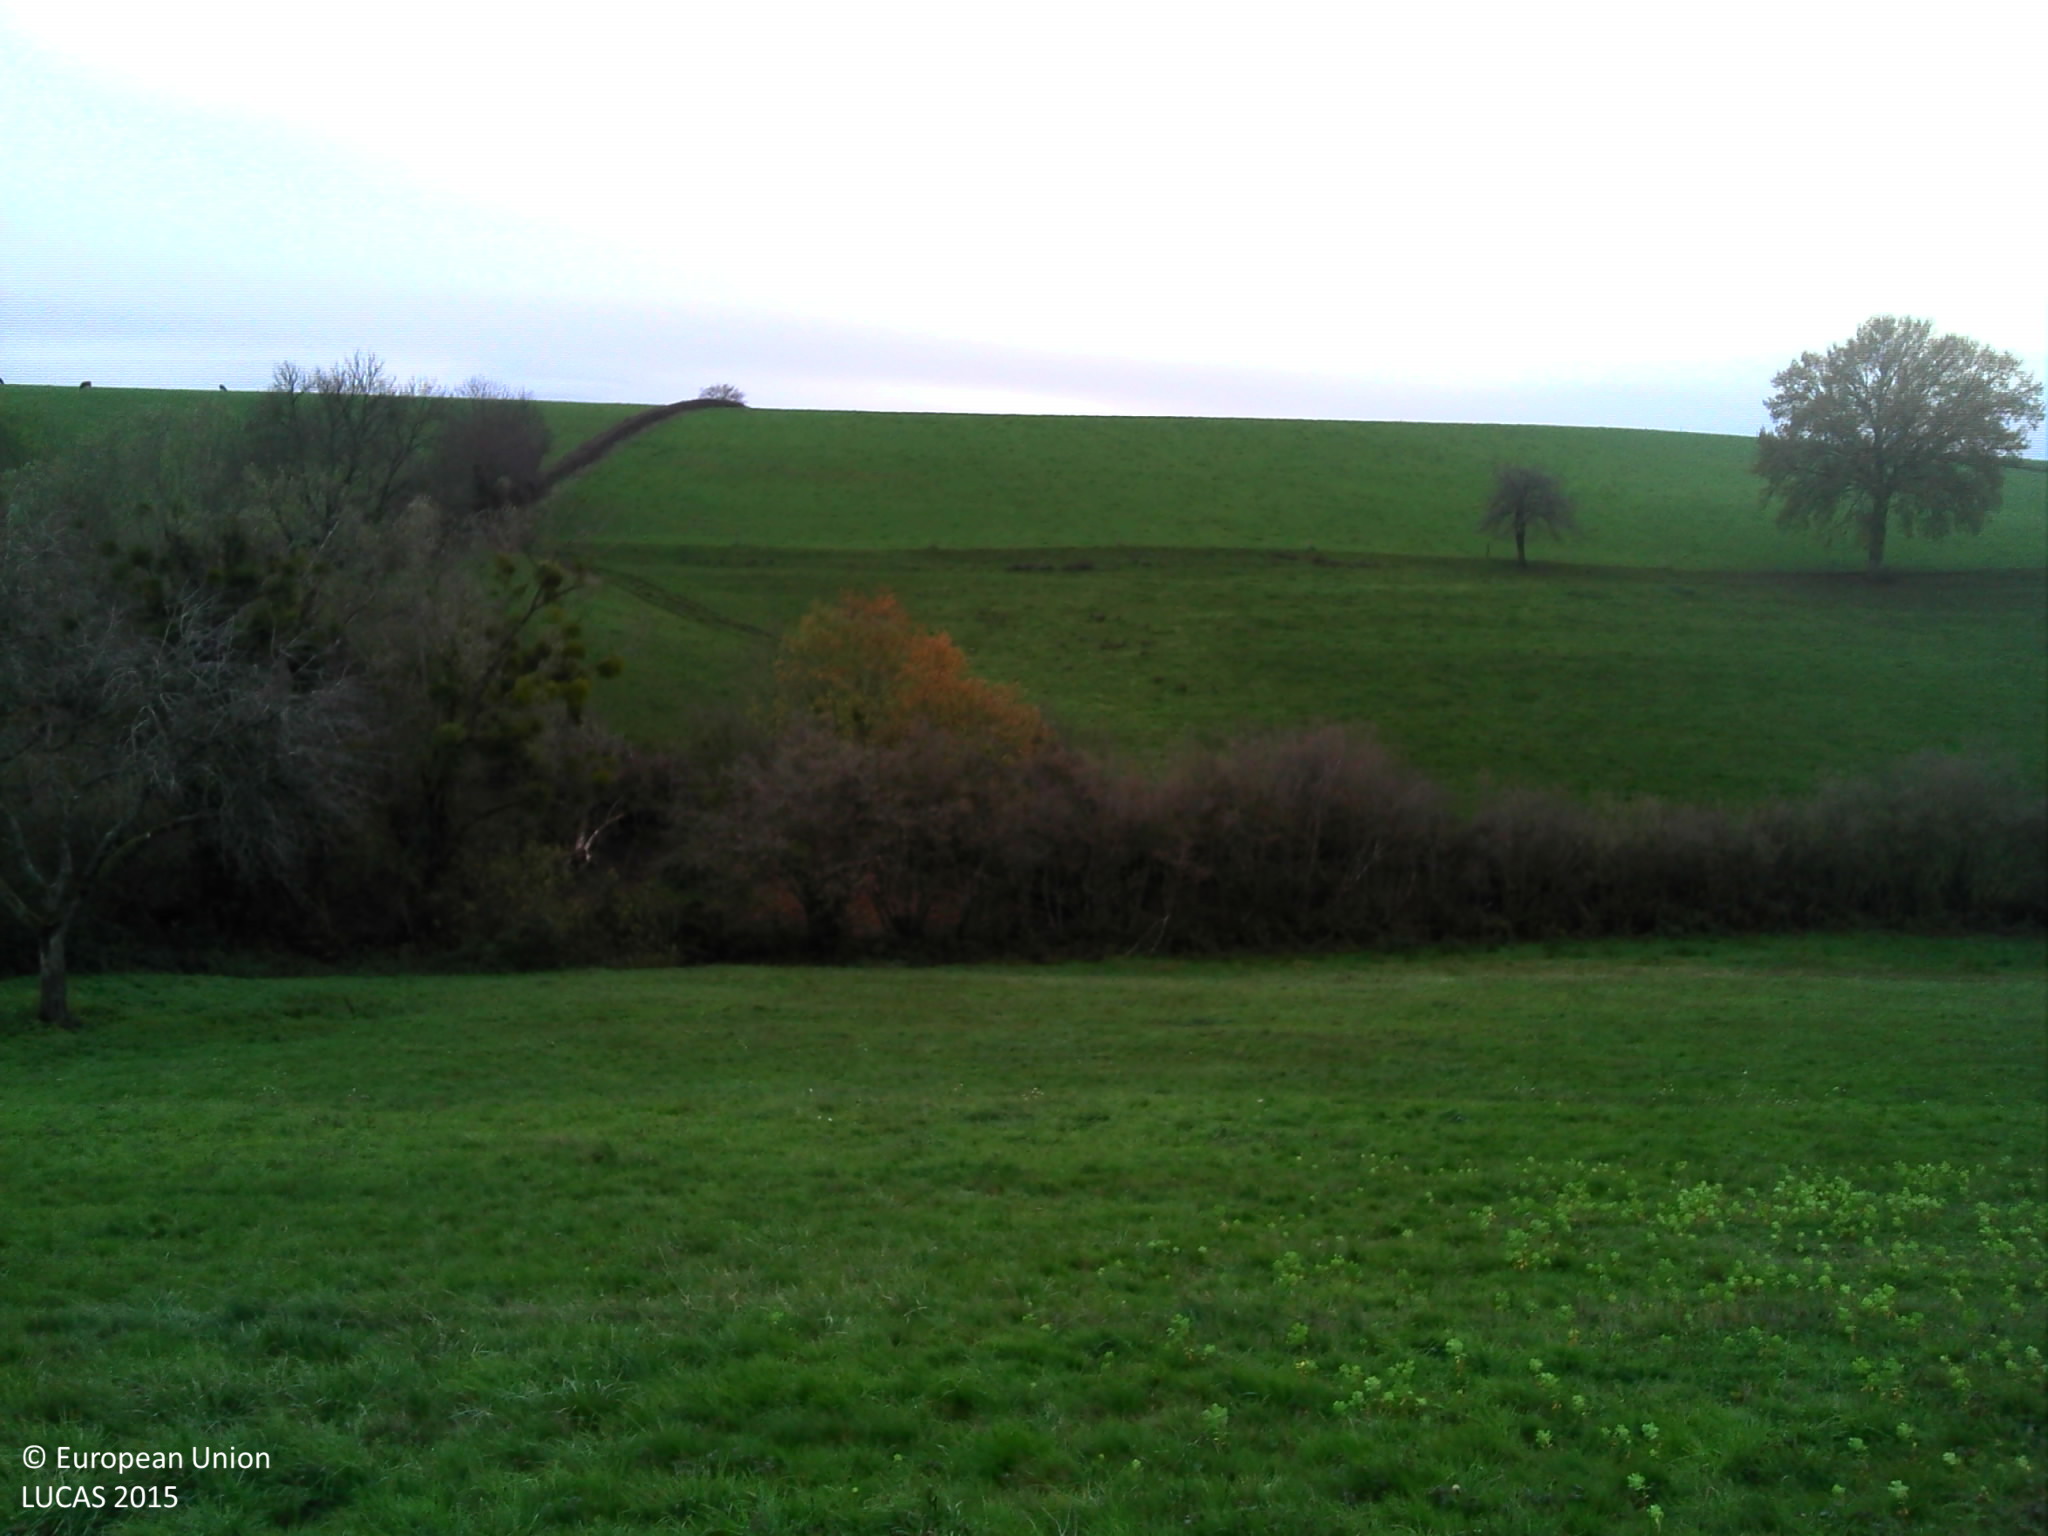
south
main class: Grassland
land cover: Grassland without tree/shrub cover
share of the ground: > 75 %
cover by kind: herbaceous plants 100 %
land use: Agriculture (excluding fallow land and kitchen gardens)
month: November
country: FR
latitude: 46.3639
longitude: 3.6958
